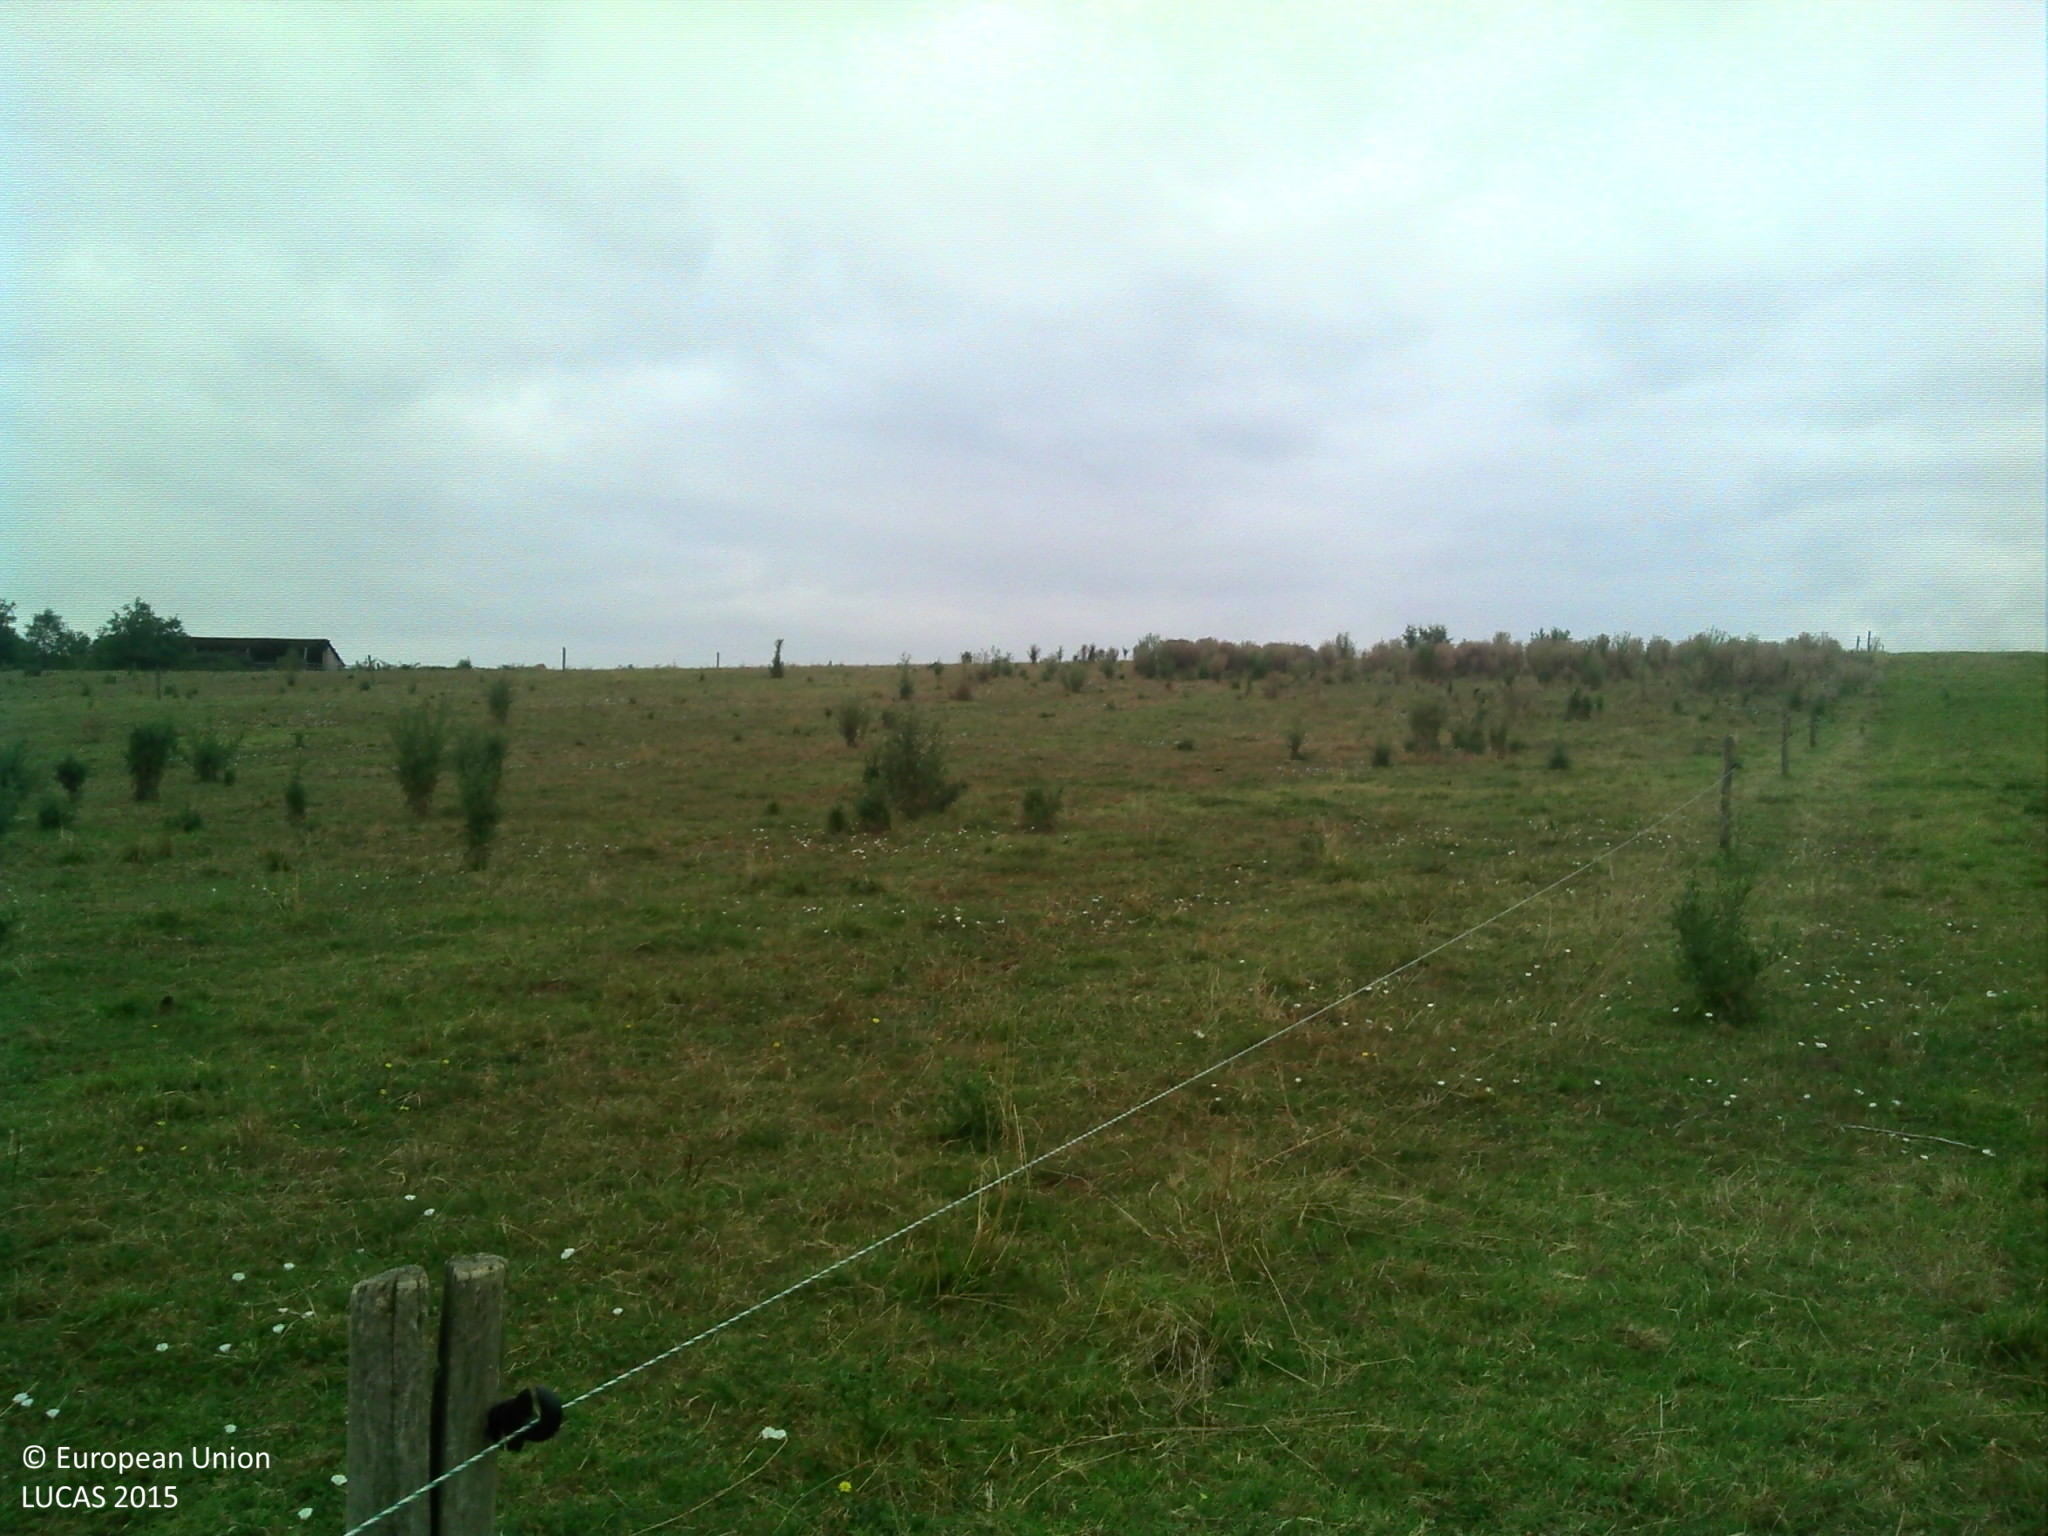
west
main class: Grassland
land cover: Grassland without tree/shrub cover
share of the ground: > 75 %
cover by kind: herbaceous plants 100 %
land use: Agriculture (excluding fallow land and kitchen gardens)
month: July
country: FR
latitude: 44.0250
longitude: 0.9274
